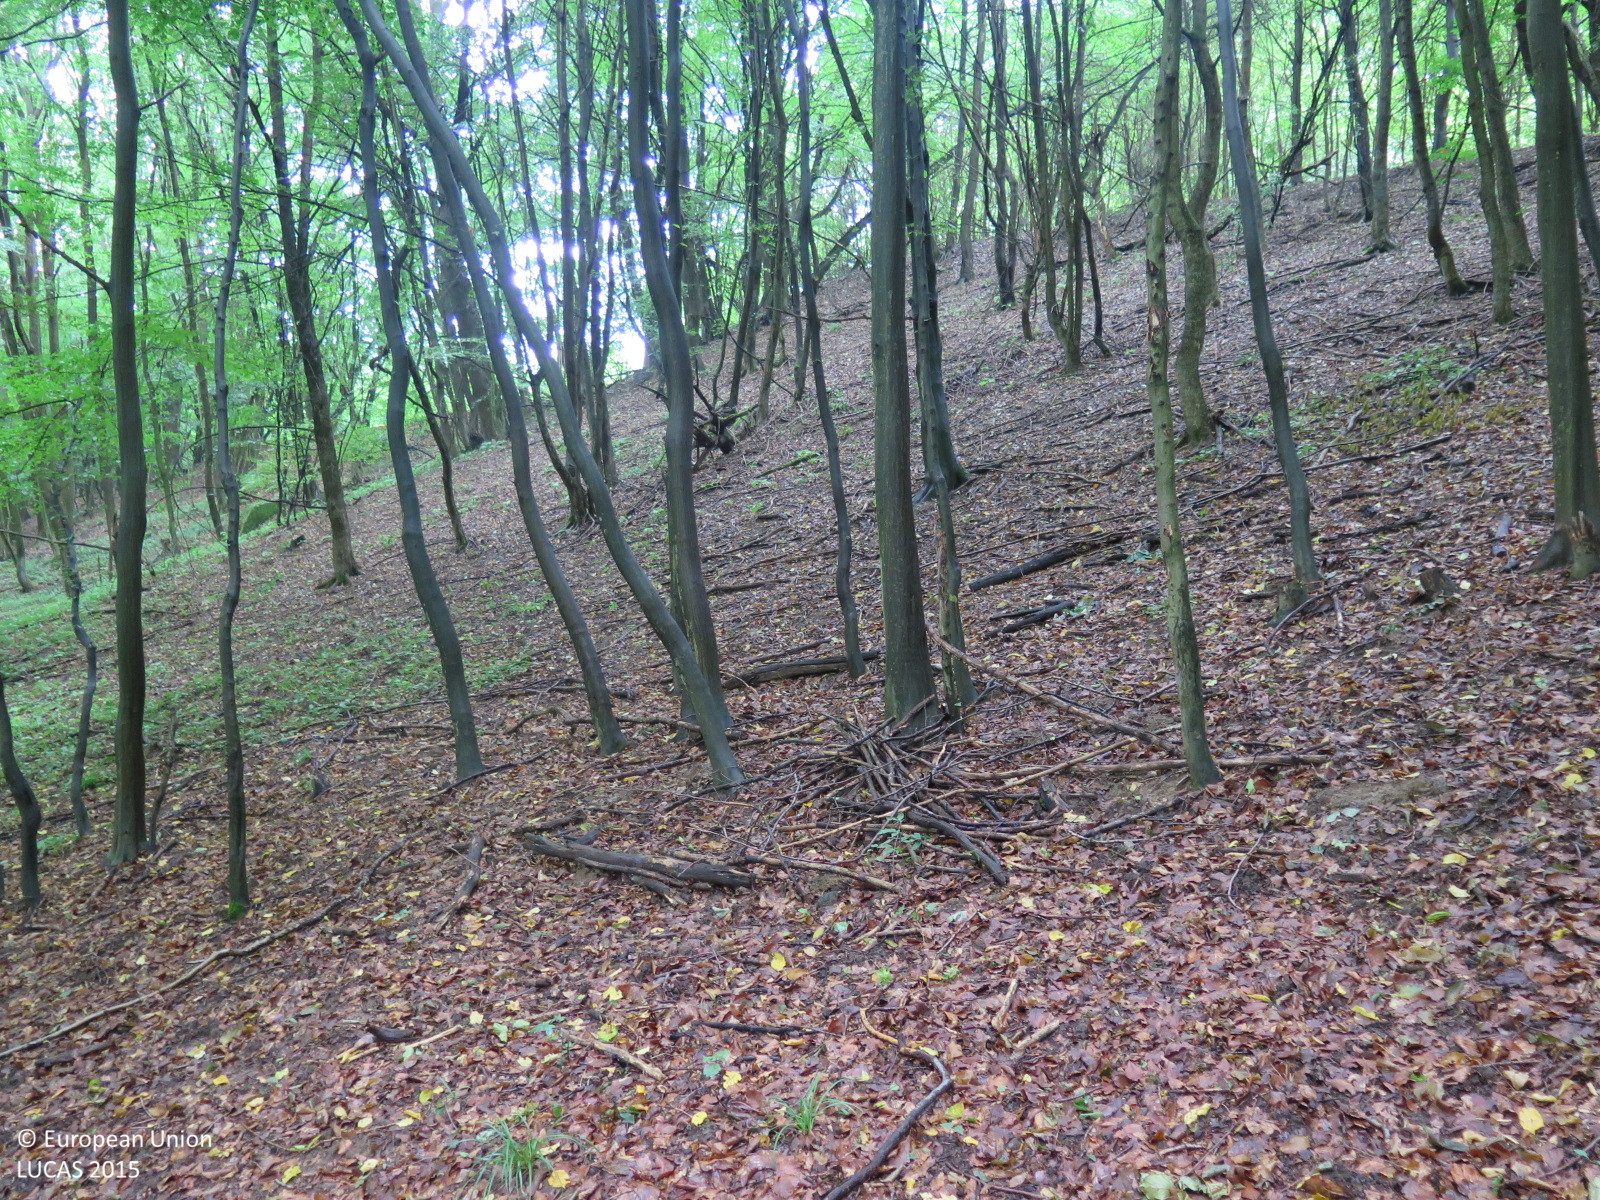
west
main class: Woodland
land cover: Broadleaved woodland
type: mesophytic deciduous forest
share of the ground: > 75 %
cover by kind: broadleaved forest trees 95 %, herbaceous plants 5 %
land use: Forestry
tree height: > 5 m
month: July
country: CZ
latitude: 49.1324
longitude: 17.6463
